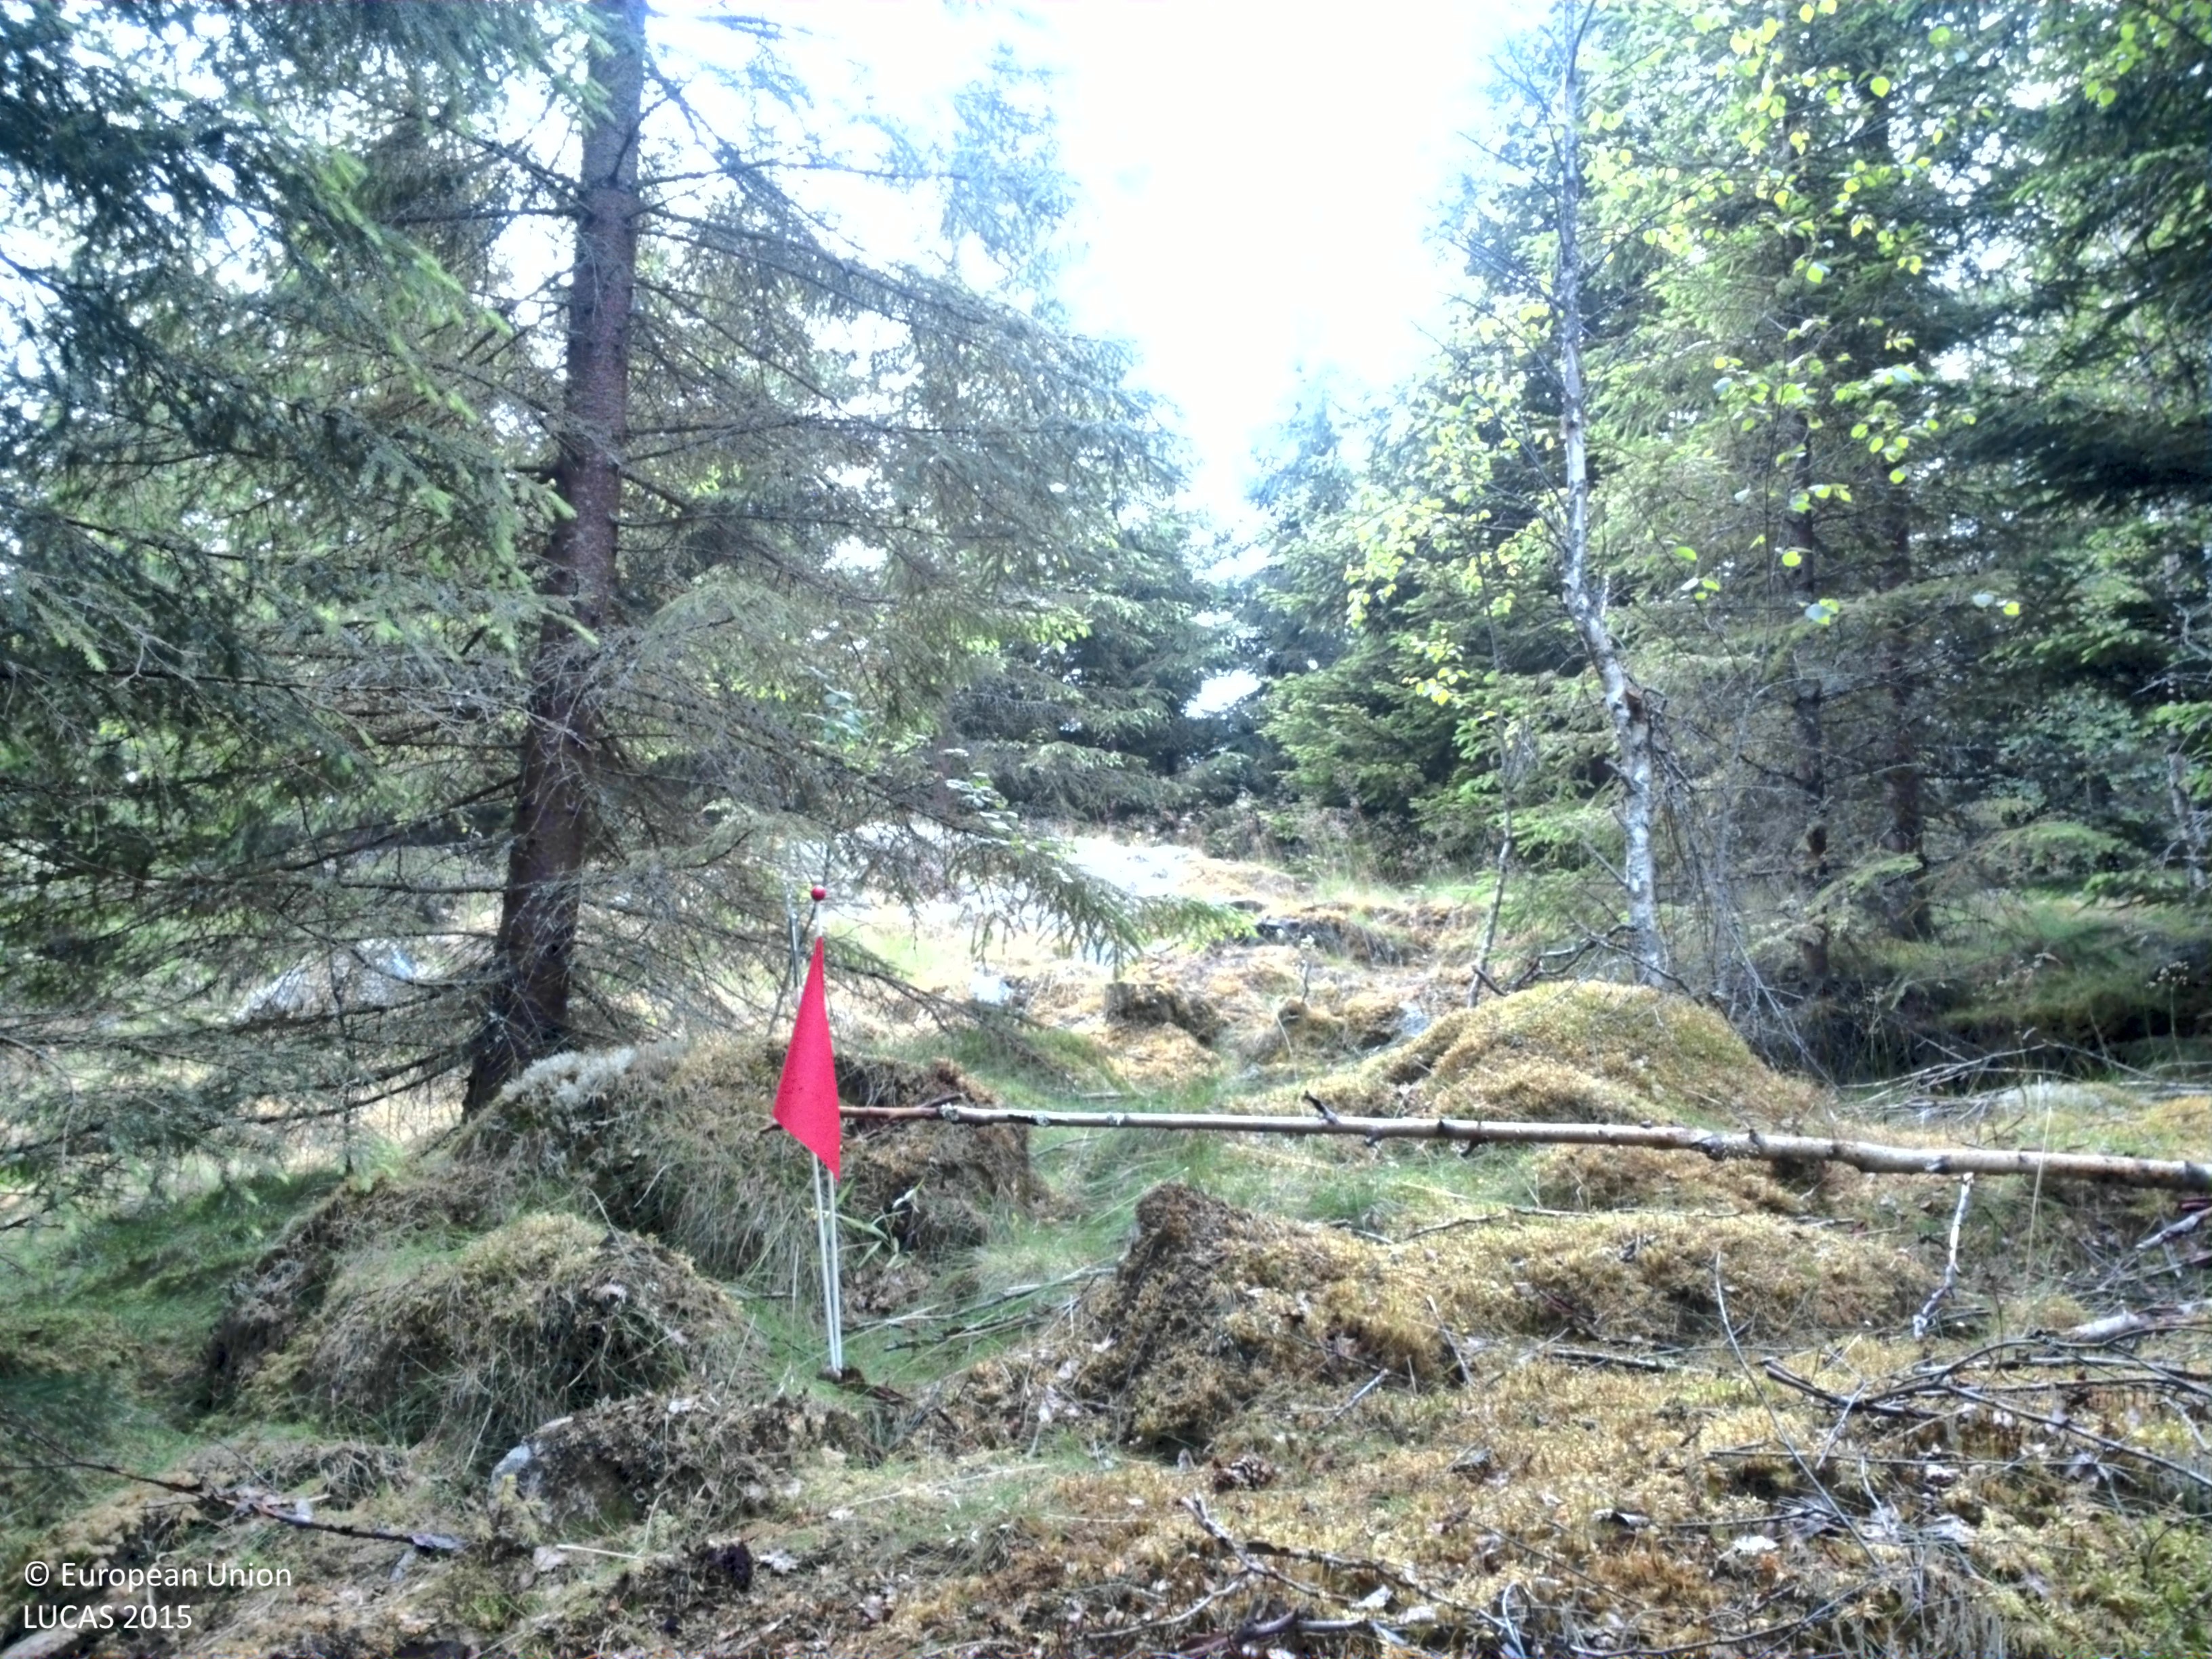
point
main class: Woodland
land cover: Spruce dominated coniferous woodland
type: boreal forest
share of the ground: > 75 %
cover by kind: coniferous forest trees 70 %, lichens and mosses 15 %, herbaceous plants 10 %, broadleaved forest trees 5 %
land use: Forestry
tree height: > 5 m
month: July
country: SE
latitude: 57.6252
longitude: 14.3992
